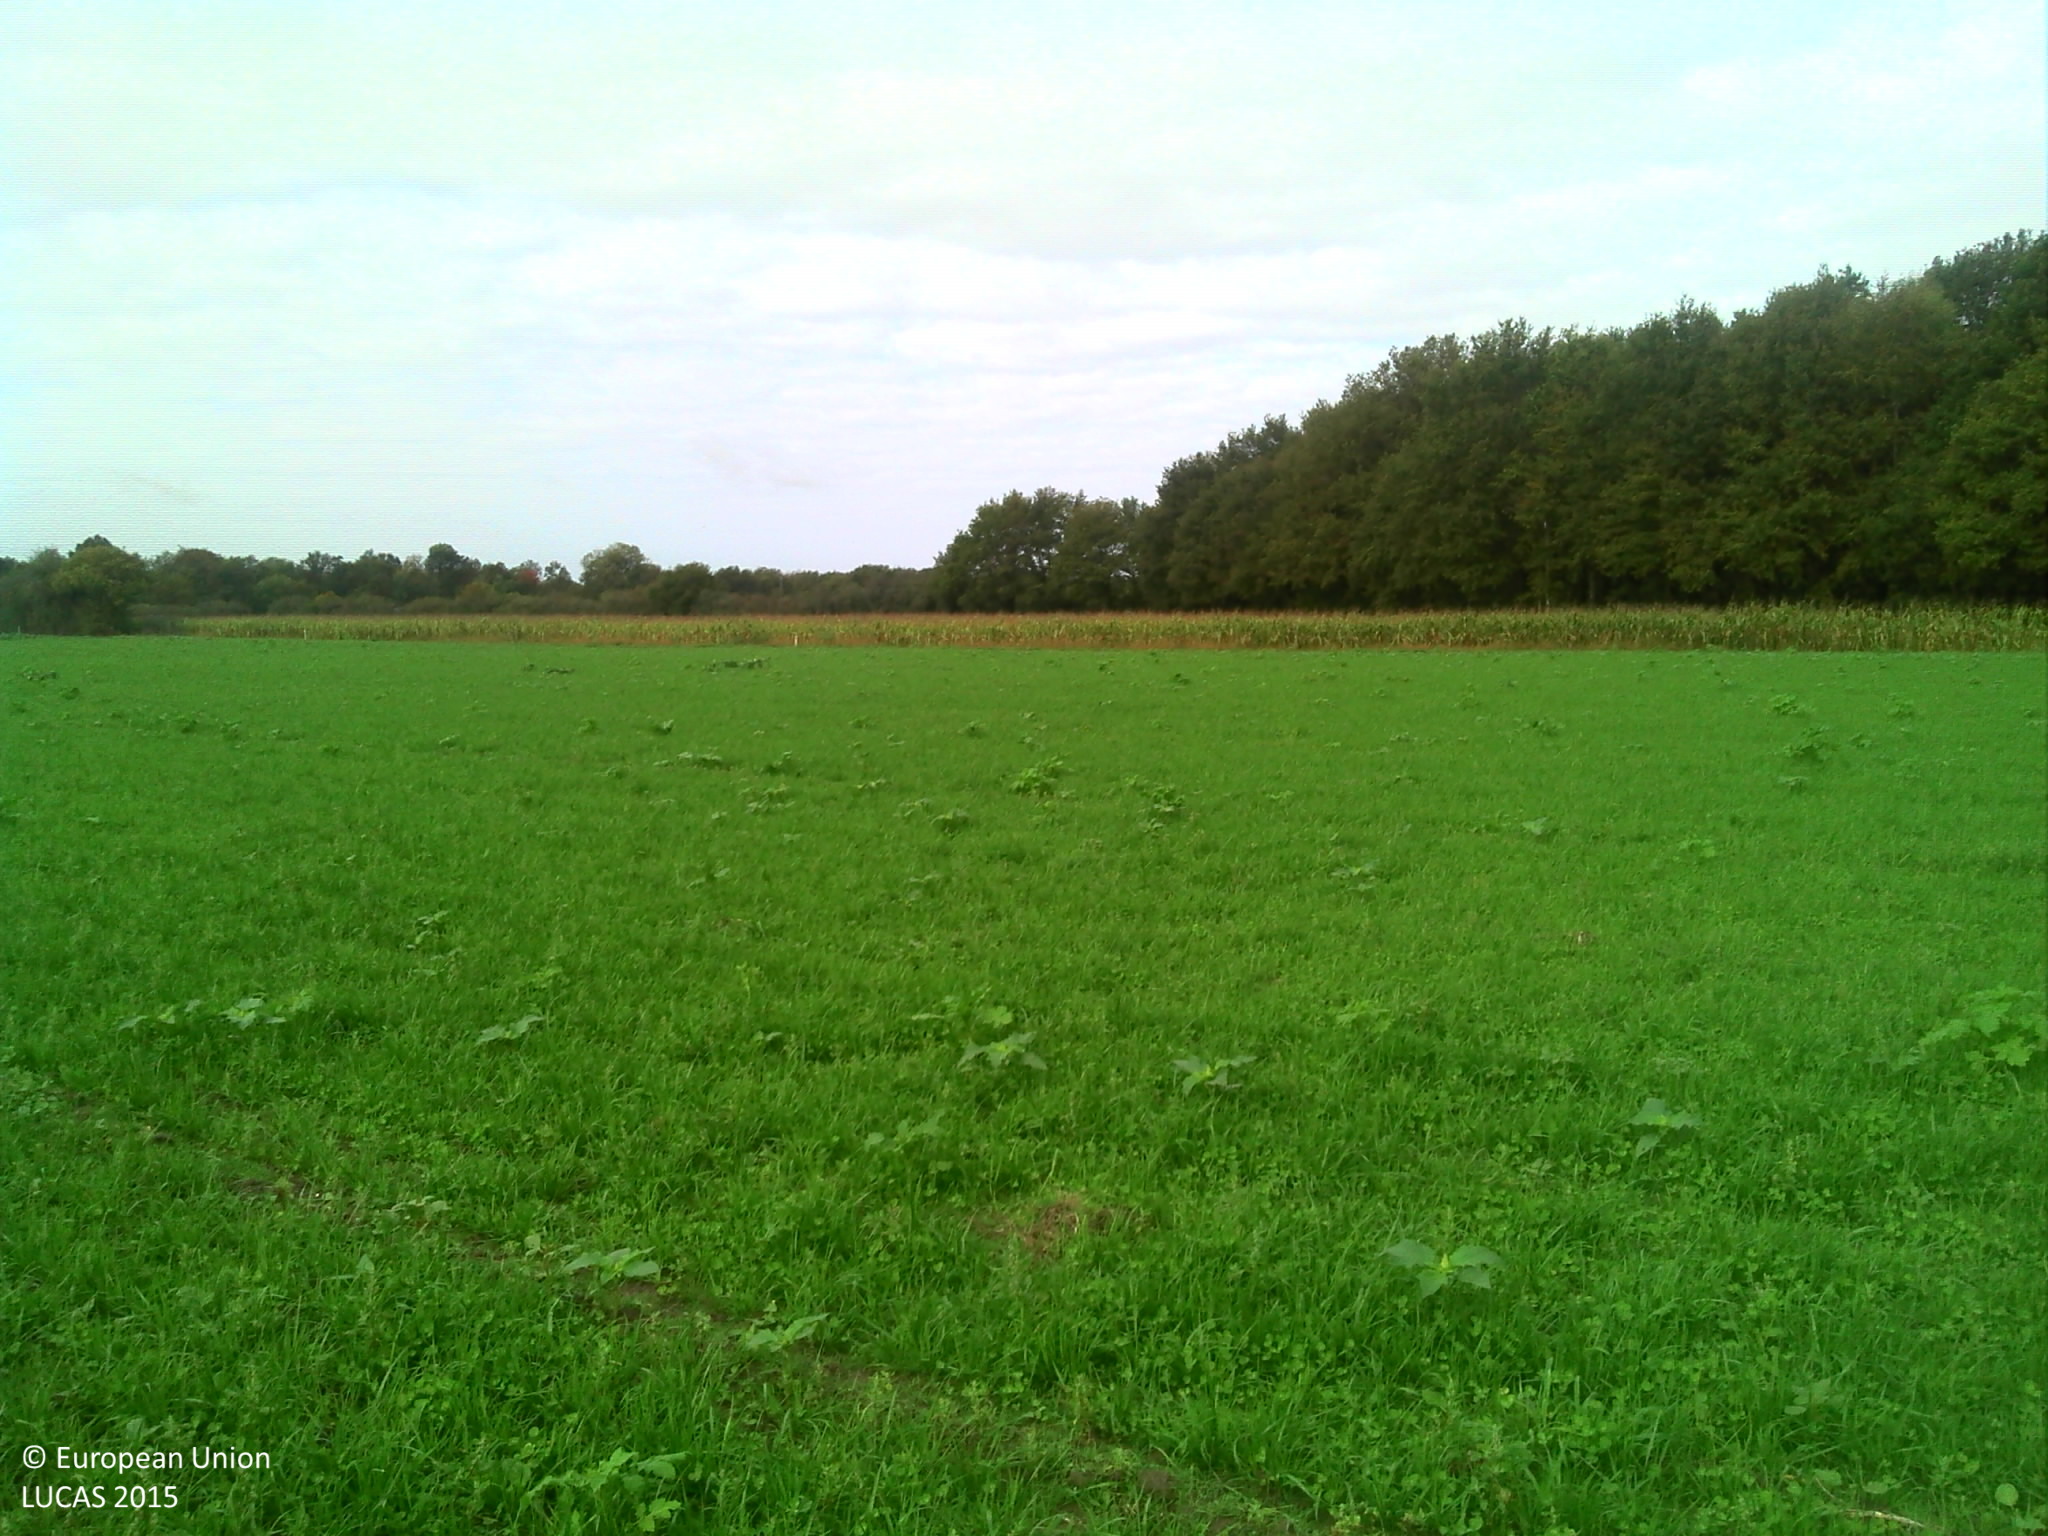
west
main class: Cropland
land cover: Temporary grasslands
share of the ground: > 75 %
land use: Agriculture (excluding fallow land and kitchen gardens)
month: October
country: FR
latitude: 47.5607
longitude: 2.1084
